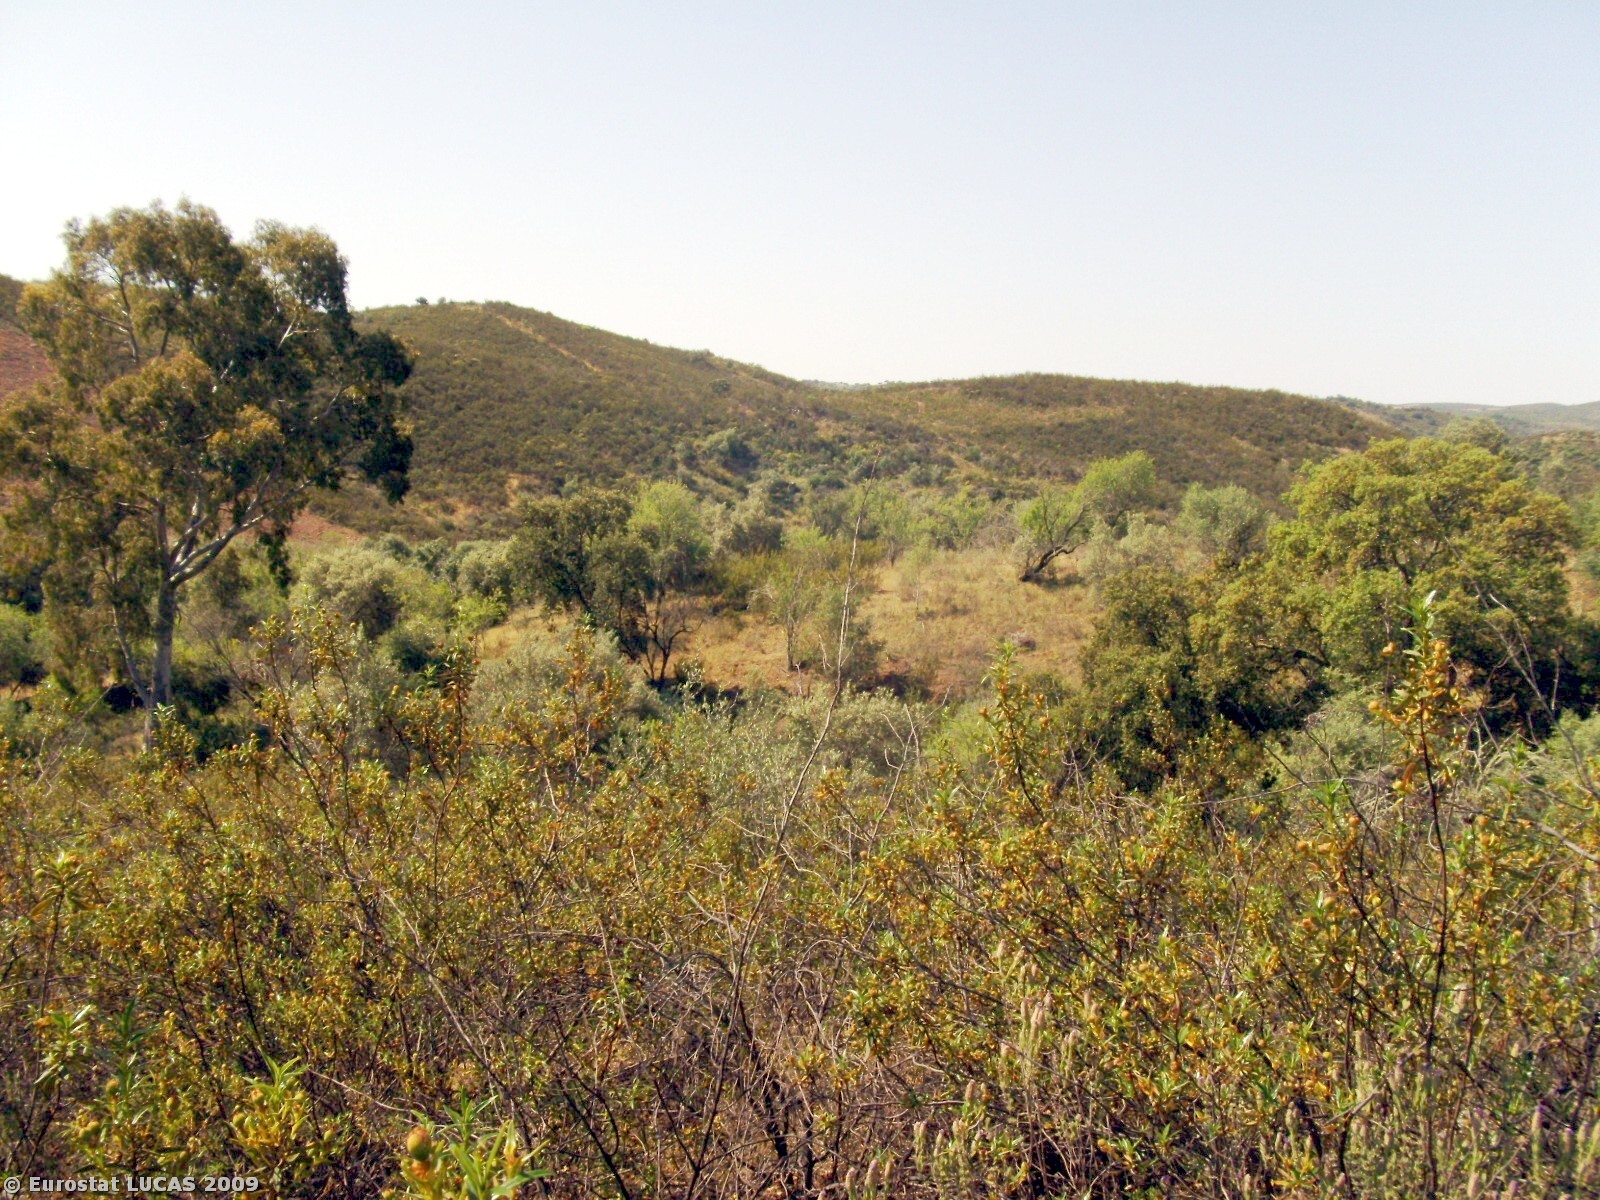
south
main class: Shrubland
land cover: Shrubland with sparse tree cover
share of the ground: > 75 %
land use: Fallow land
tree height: > 5 m
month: May
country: PT
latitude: 37.5072
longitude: -7.6490
